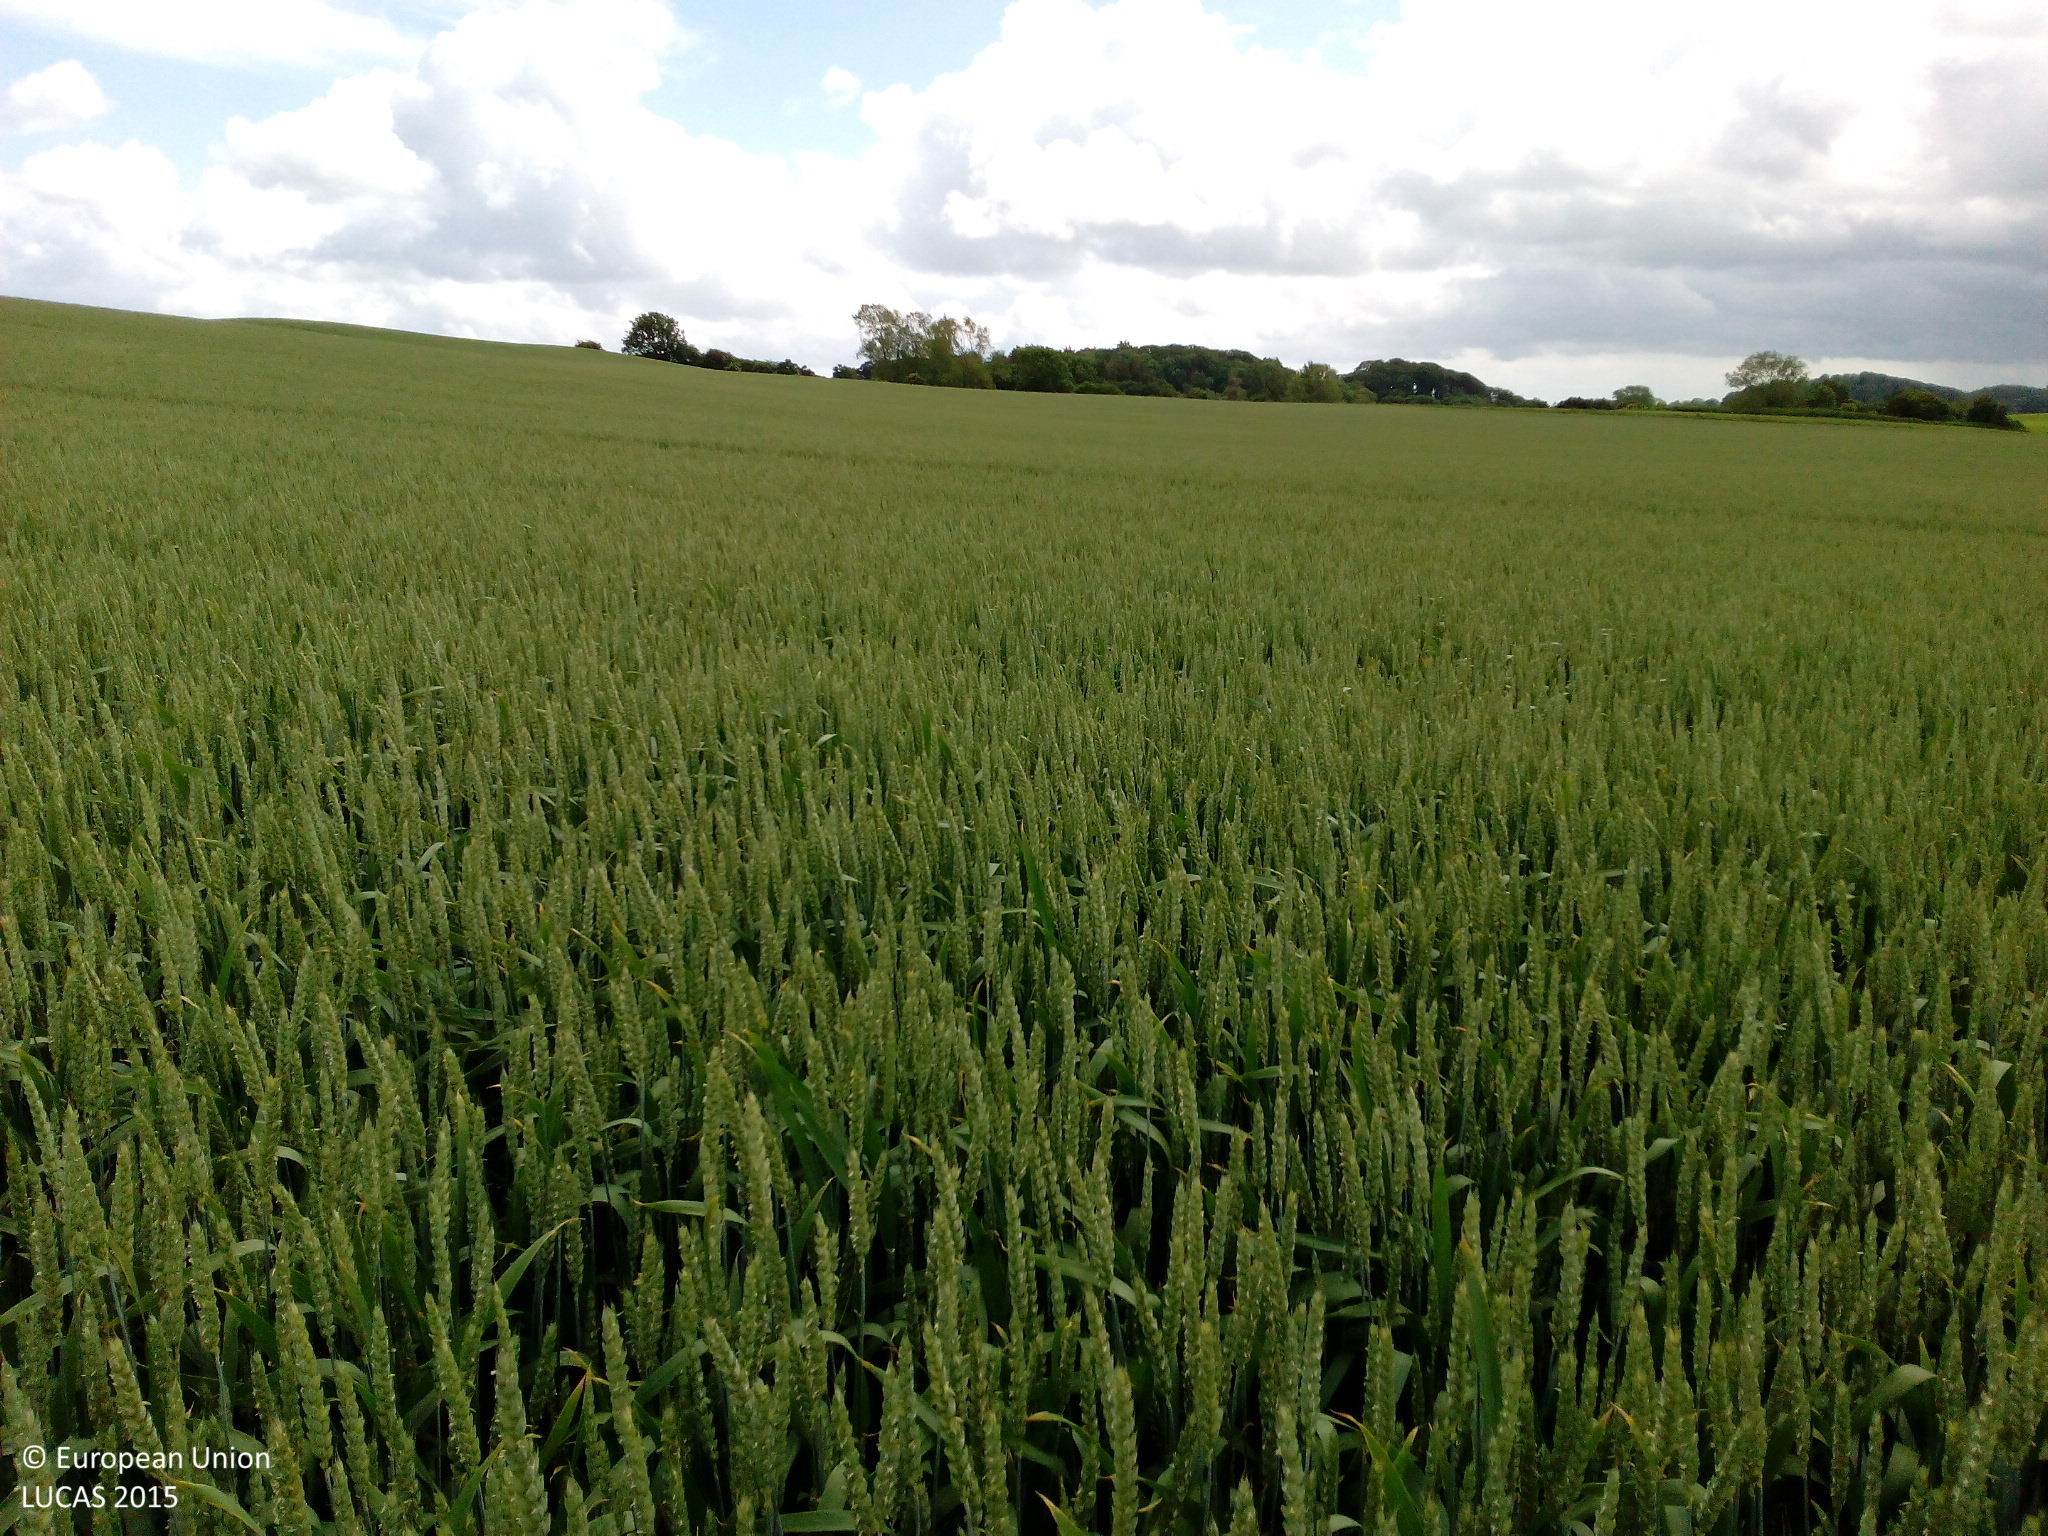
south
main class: Cropland
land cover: Common wheat
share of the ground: > 75 %
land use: Agriculture (excluding fallow land and kitchen gardens)
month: June
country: DK
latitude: 55.0165
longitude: 10.8595
